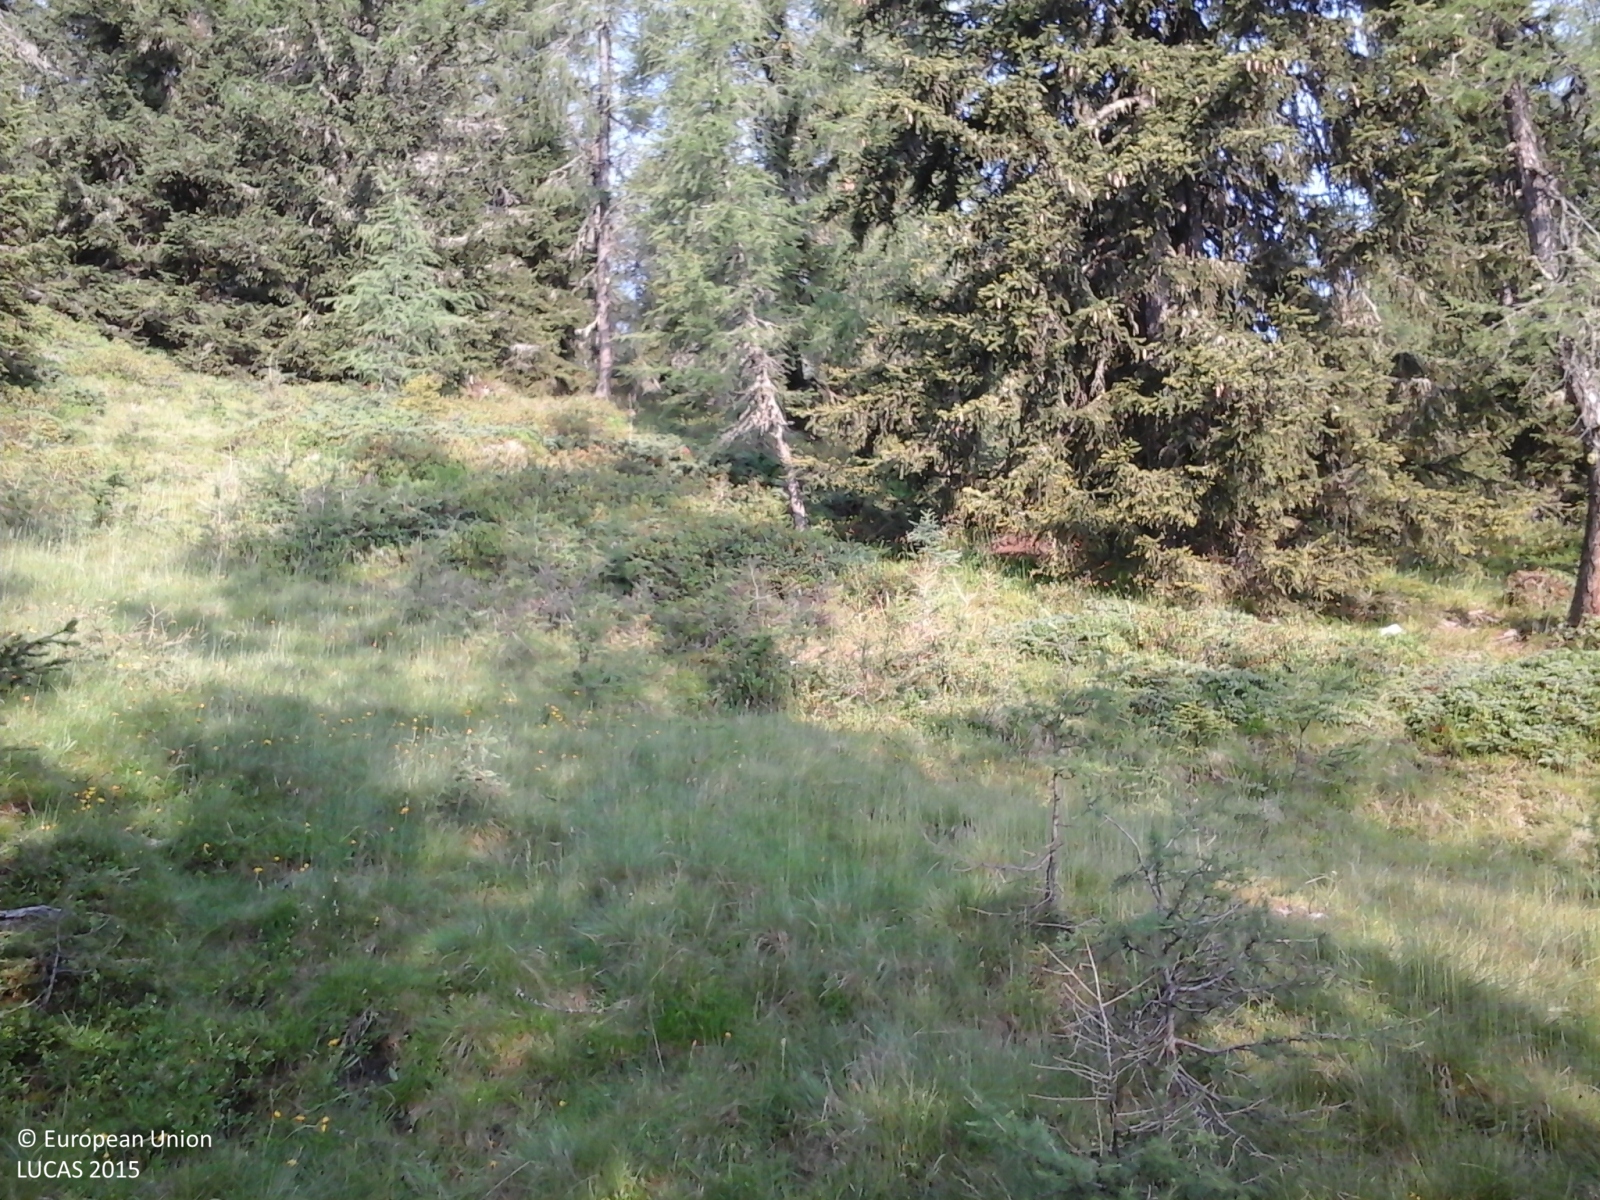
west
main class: Woodland
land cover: Spruce dominated coniferous woodland
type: alpine coniferous forest
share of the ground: 50 - 75 %
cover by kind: coniferous forest trees 100 %
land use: Forestry
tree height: > 5 m
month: July
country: IT
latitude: 46.7473
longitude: 11.9745
